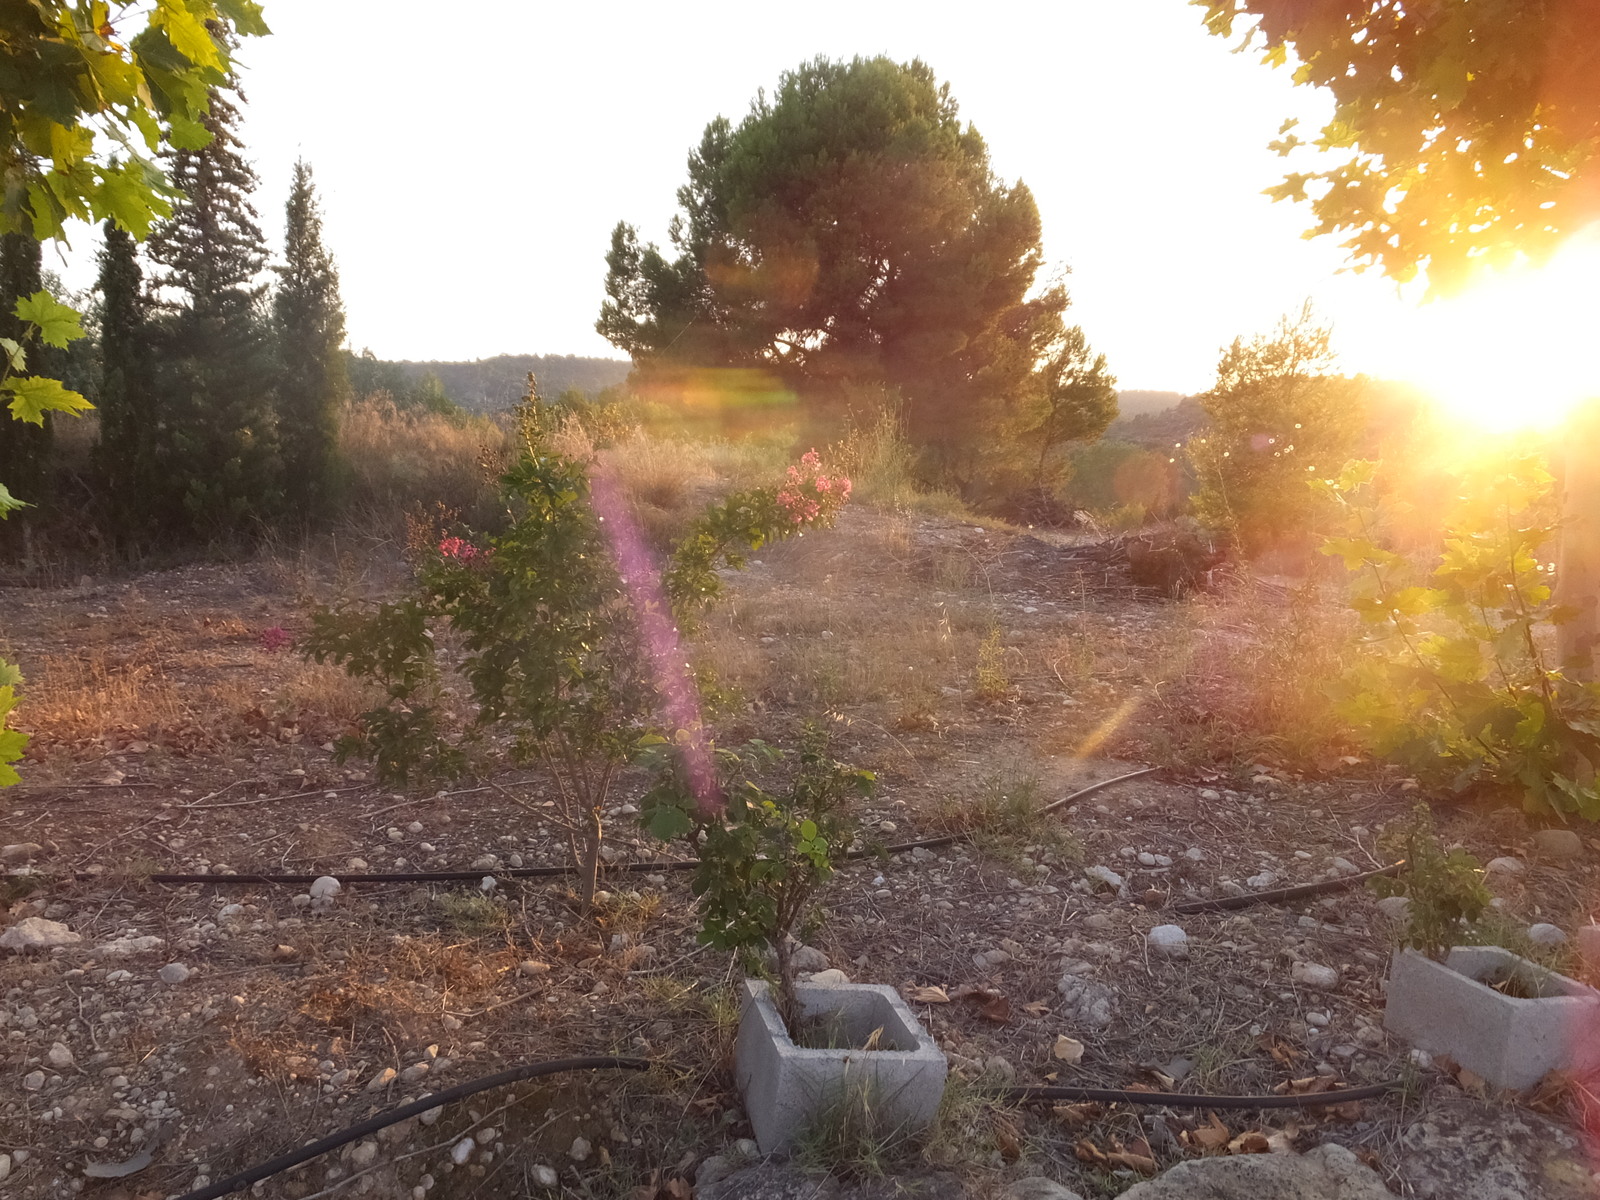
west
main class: Grassland
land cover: Grassland without tree/shrub cover
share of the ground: > 75 %
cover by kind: herbaceous plants 100 %
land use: Logistics and storage
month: July
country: ES
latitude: 41.0787
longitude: 0.1224
